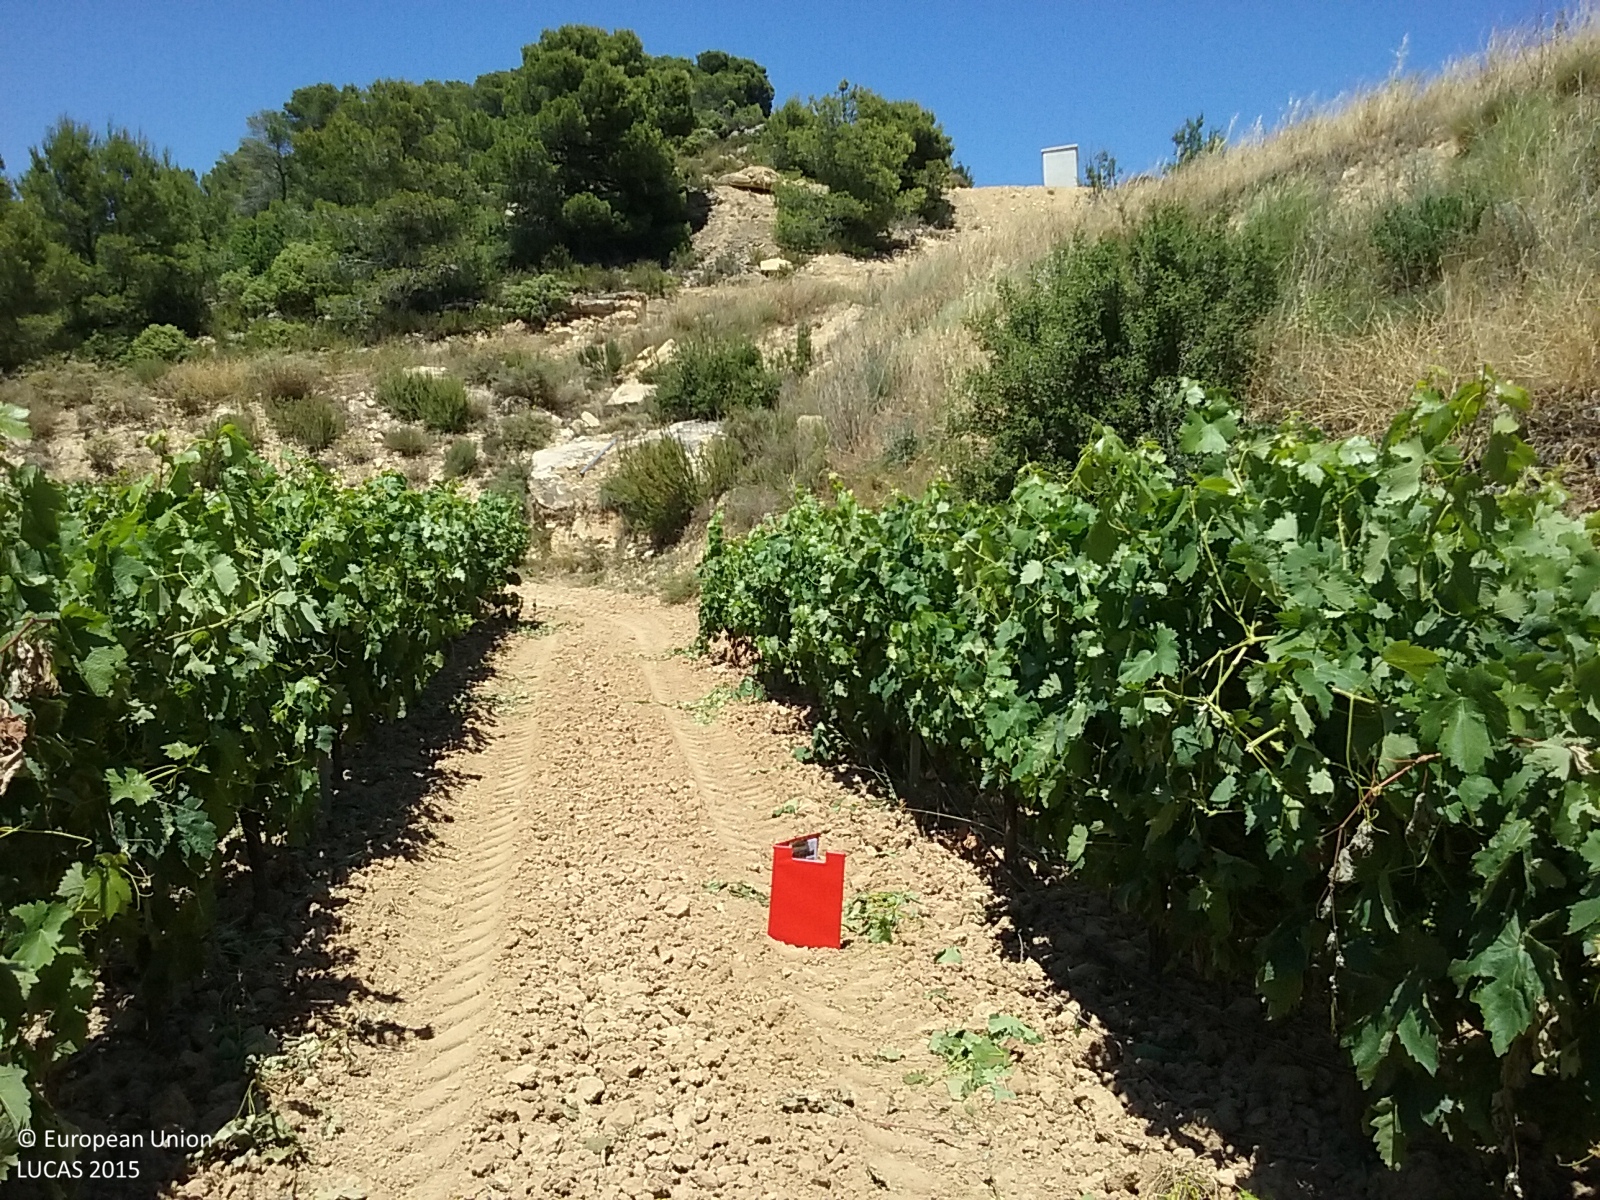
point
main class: Cropland
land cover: Vineyards
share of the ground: 10 - 25 %
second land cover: Other bare soil
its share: > 75 %
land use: Agriculture (excluding fallow land and kitchen gardens)
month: June
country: ES
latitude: 41.0996
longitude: 0.3344
